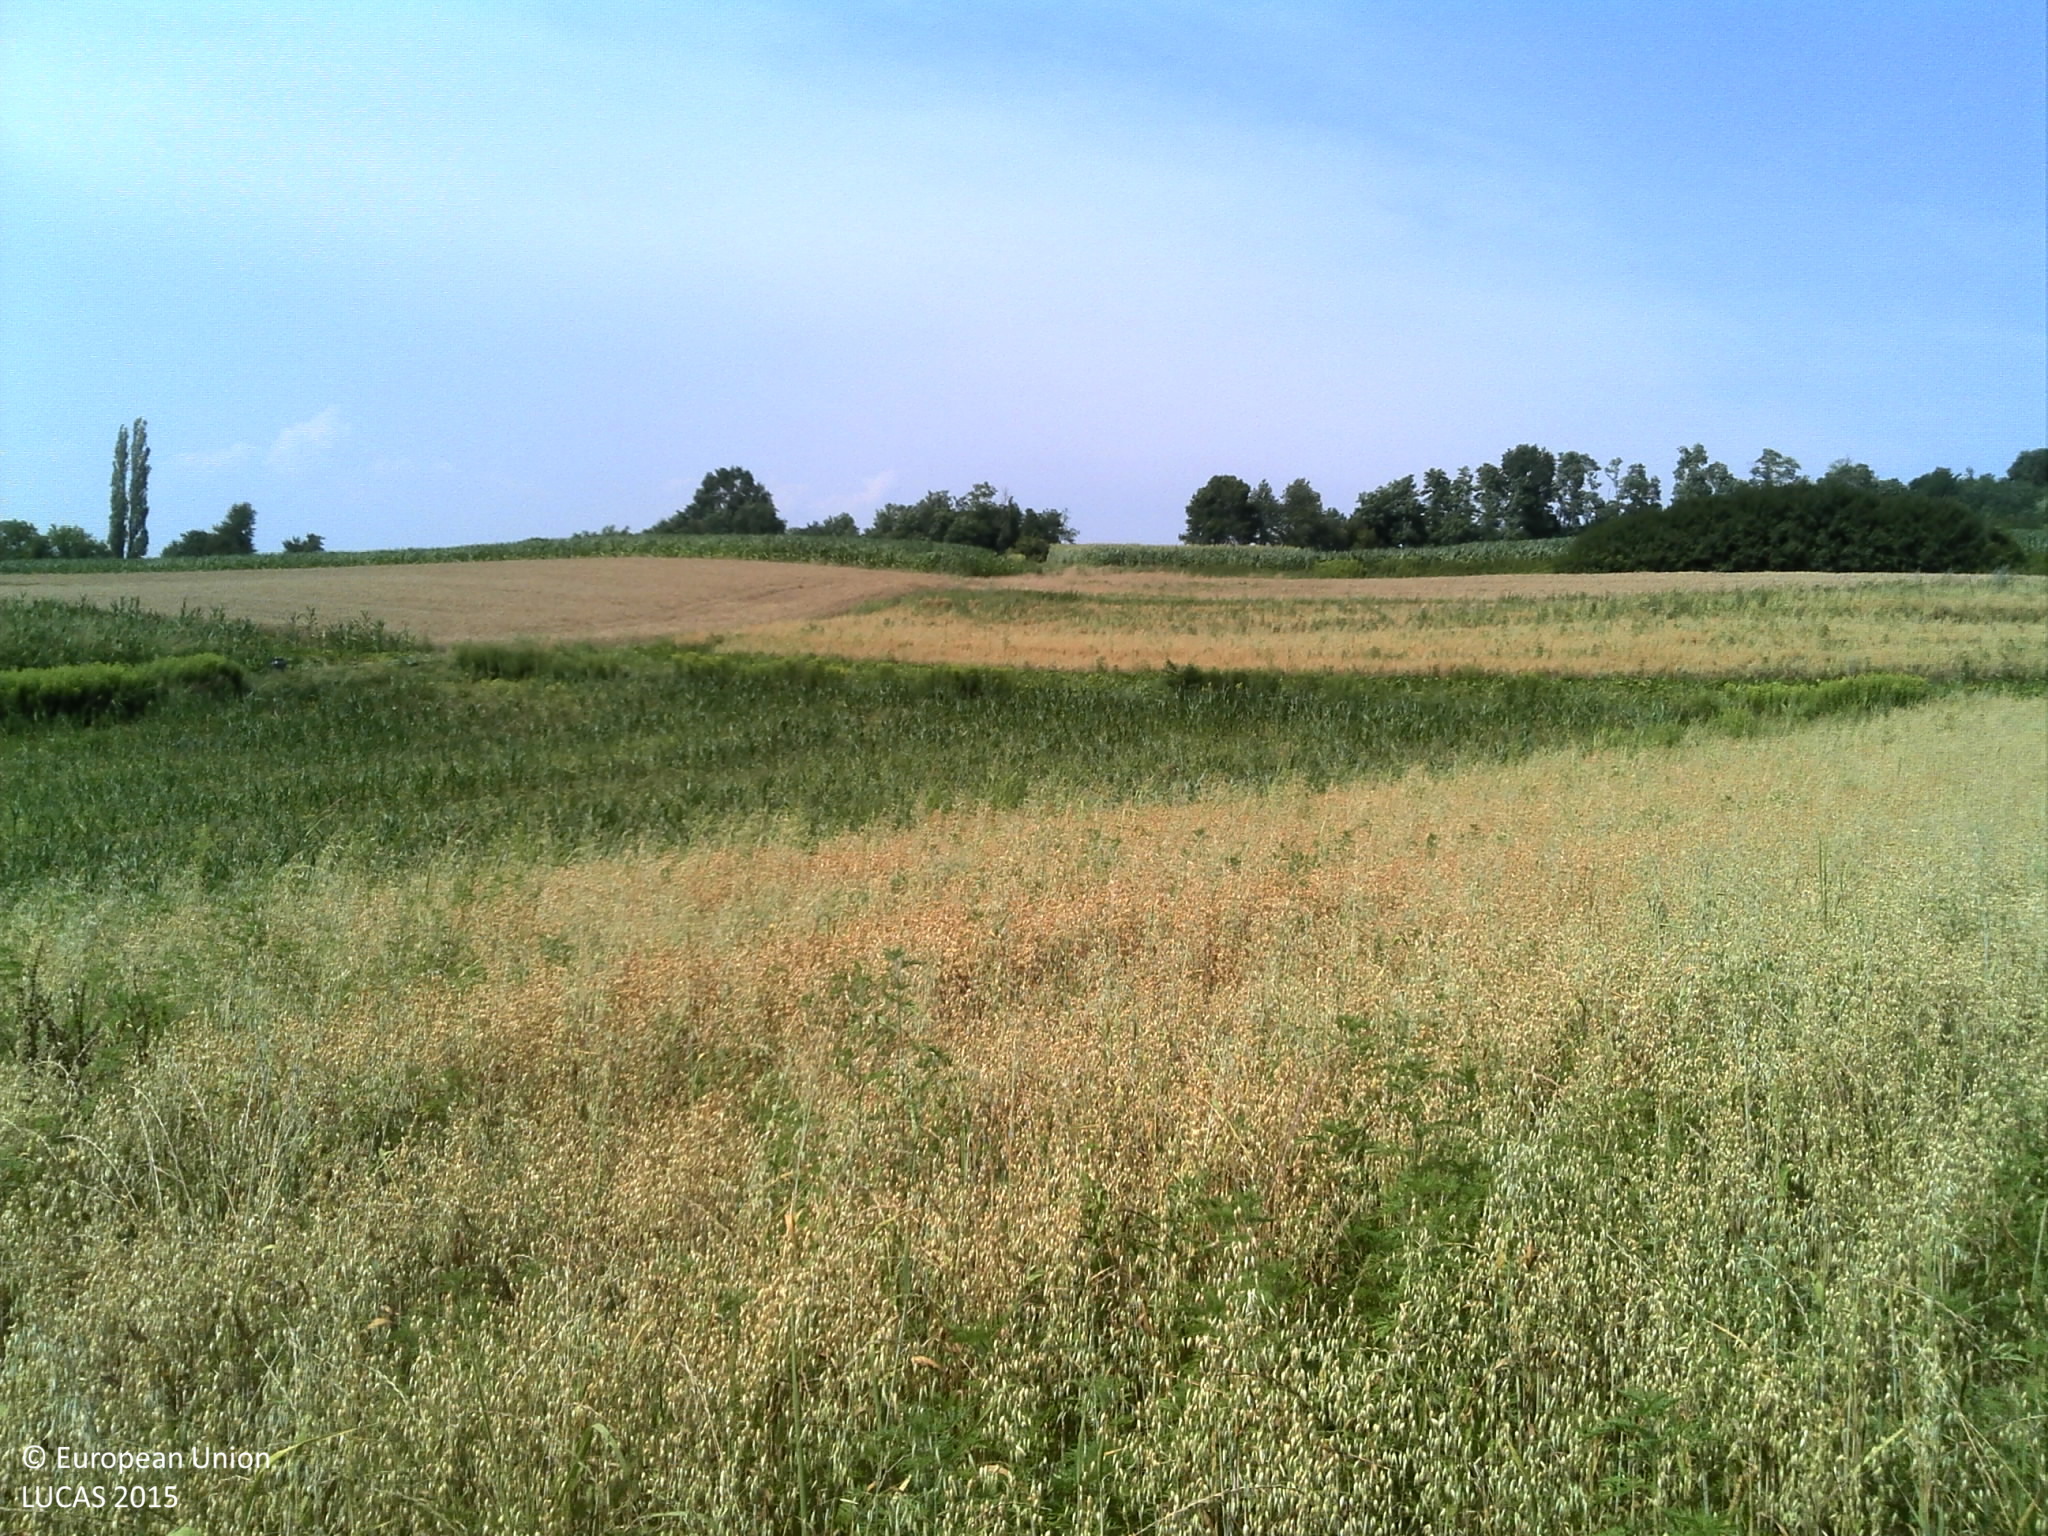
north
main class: Cropland
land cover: Oats
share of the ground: > 75 %
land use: Agriculture (excluding fallow land and kitchen gardens)
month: July
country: HR
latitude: 46.0111
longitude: 16.7551
